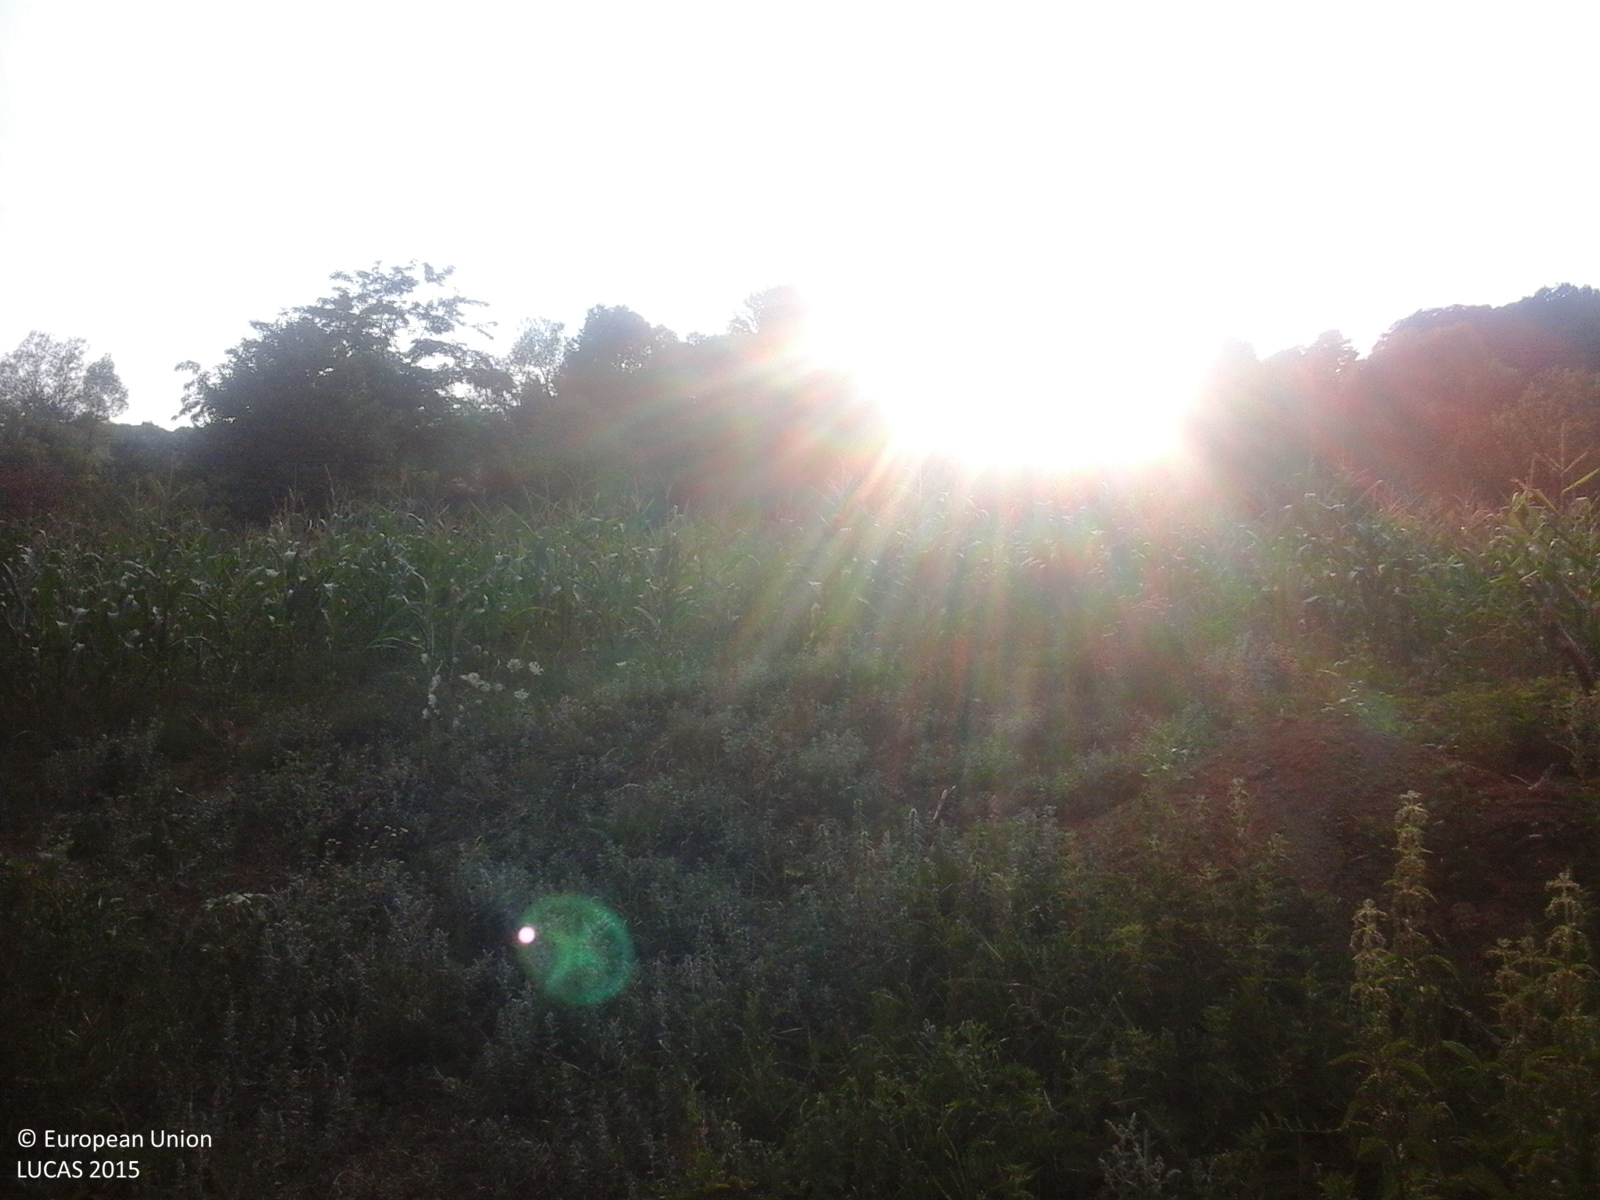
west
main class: Cropland
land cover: Maize
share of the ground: > 75 %
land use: Agriculture (excluding fallow land and kitchen gardens)
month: July
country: RO
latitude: 46.1804
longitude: 26.8392
